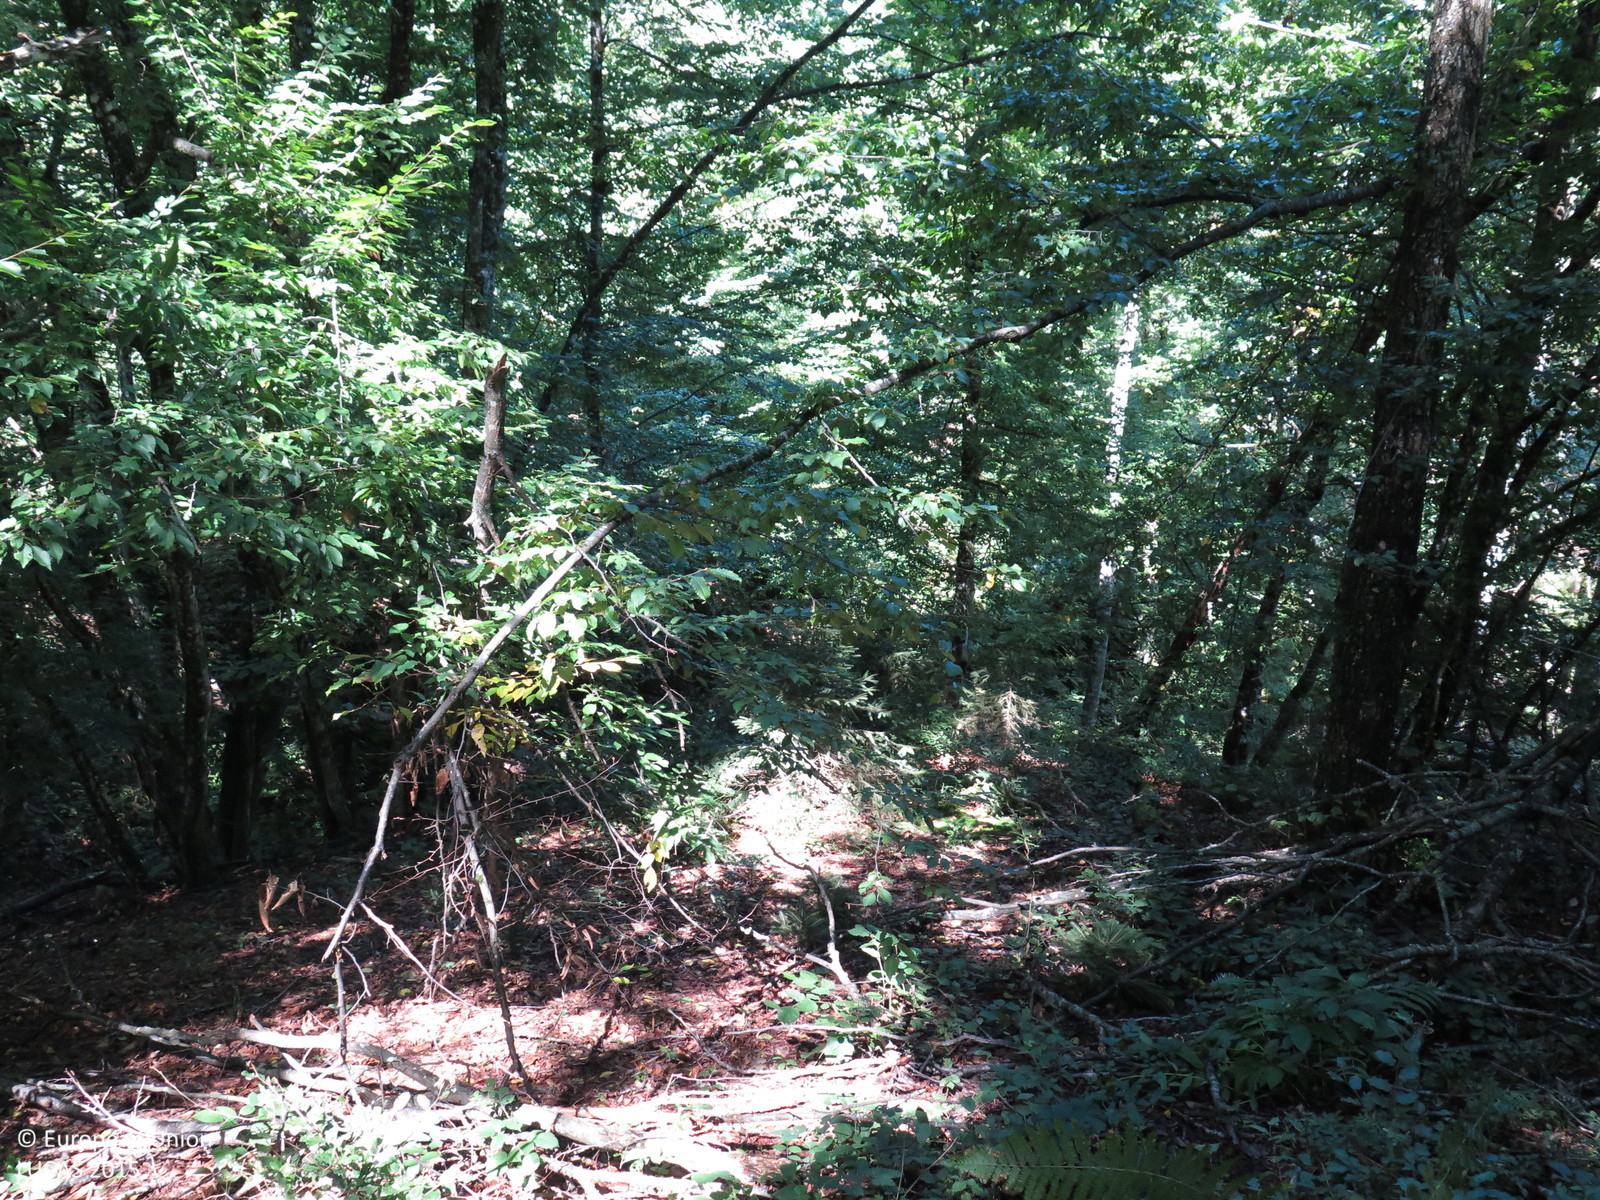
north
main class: Woodland
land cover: Broadleaved woodland
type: mountainous beech forest
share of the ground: > 75 %
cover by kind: broadleaved forest trees 90 %, shrubs 5 %, herbaceous plants 5 %
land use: Forestry
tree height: > 5 m
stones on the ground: 10 - 25 %
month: September
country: HR
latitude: 45.5635
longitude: 14.6720
